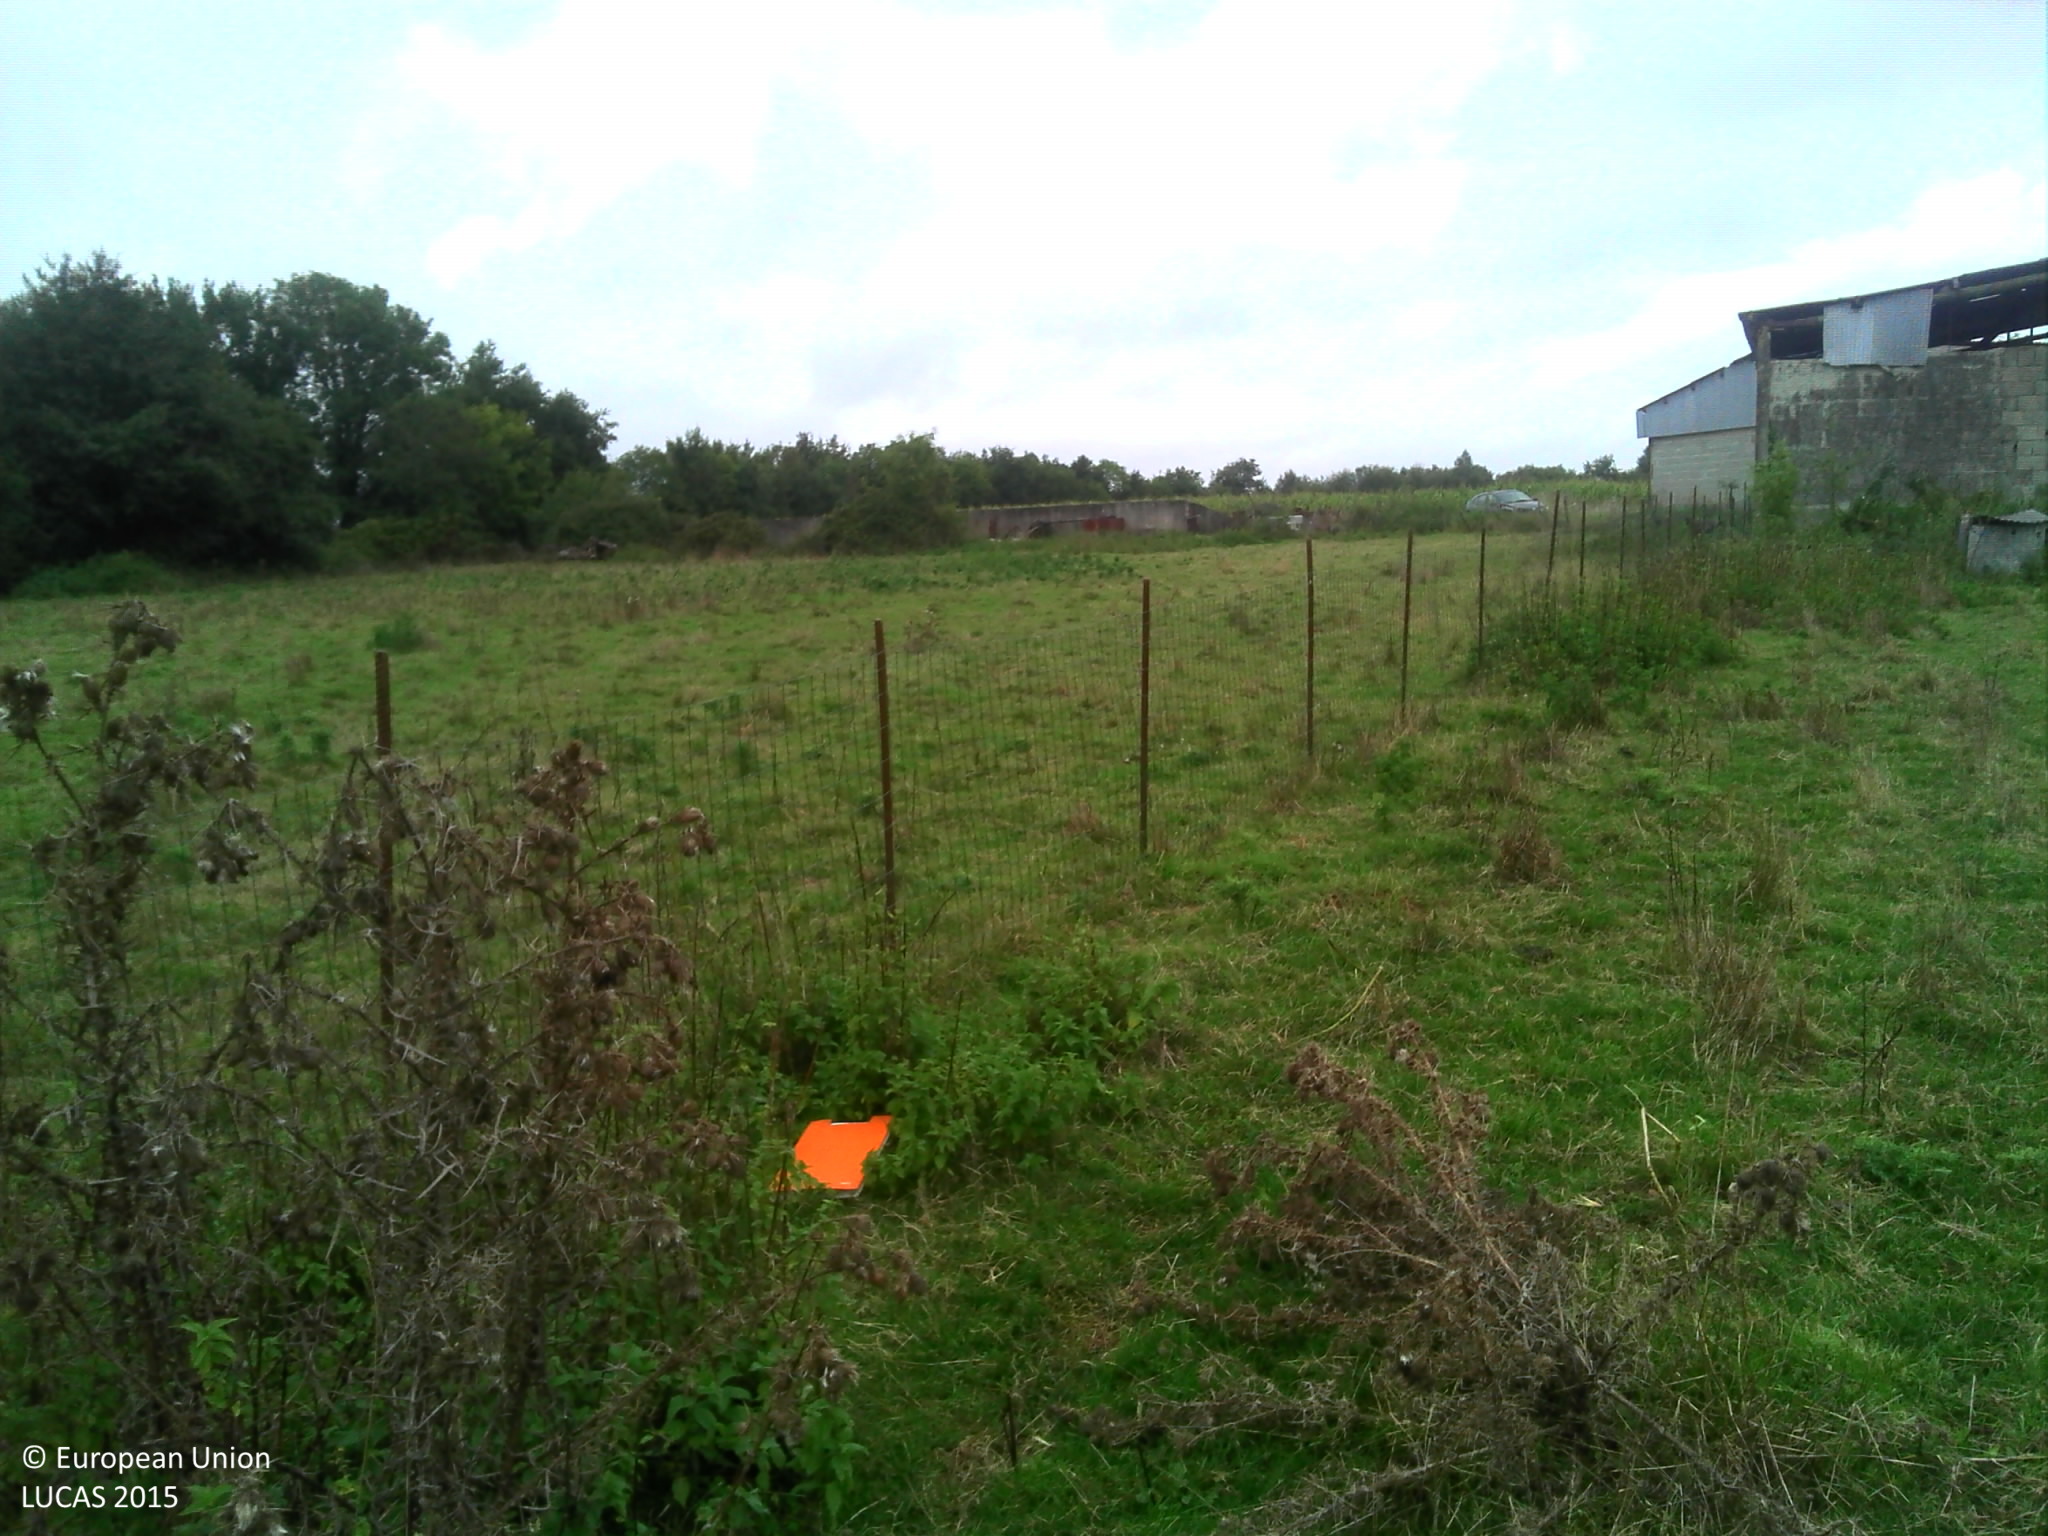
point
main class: Grassland
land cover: Grassland without tree/shrub cover
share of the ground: > 75 %
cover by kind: herbaceous plants 100 %
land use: Agriculture (excluding fallow land and kitchen gardens)
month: September
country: FR
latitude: 46.6492
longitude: -1.0478
